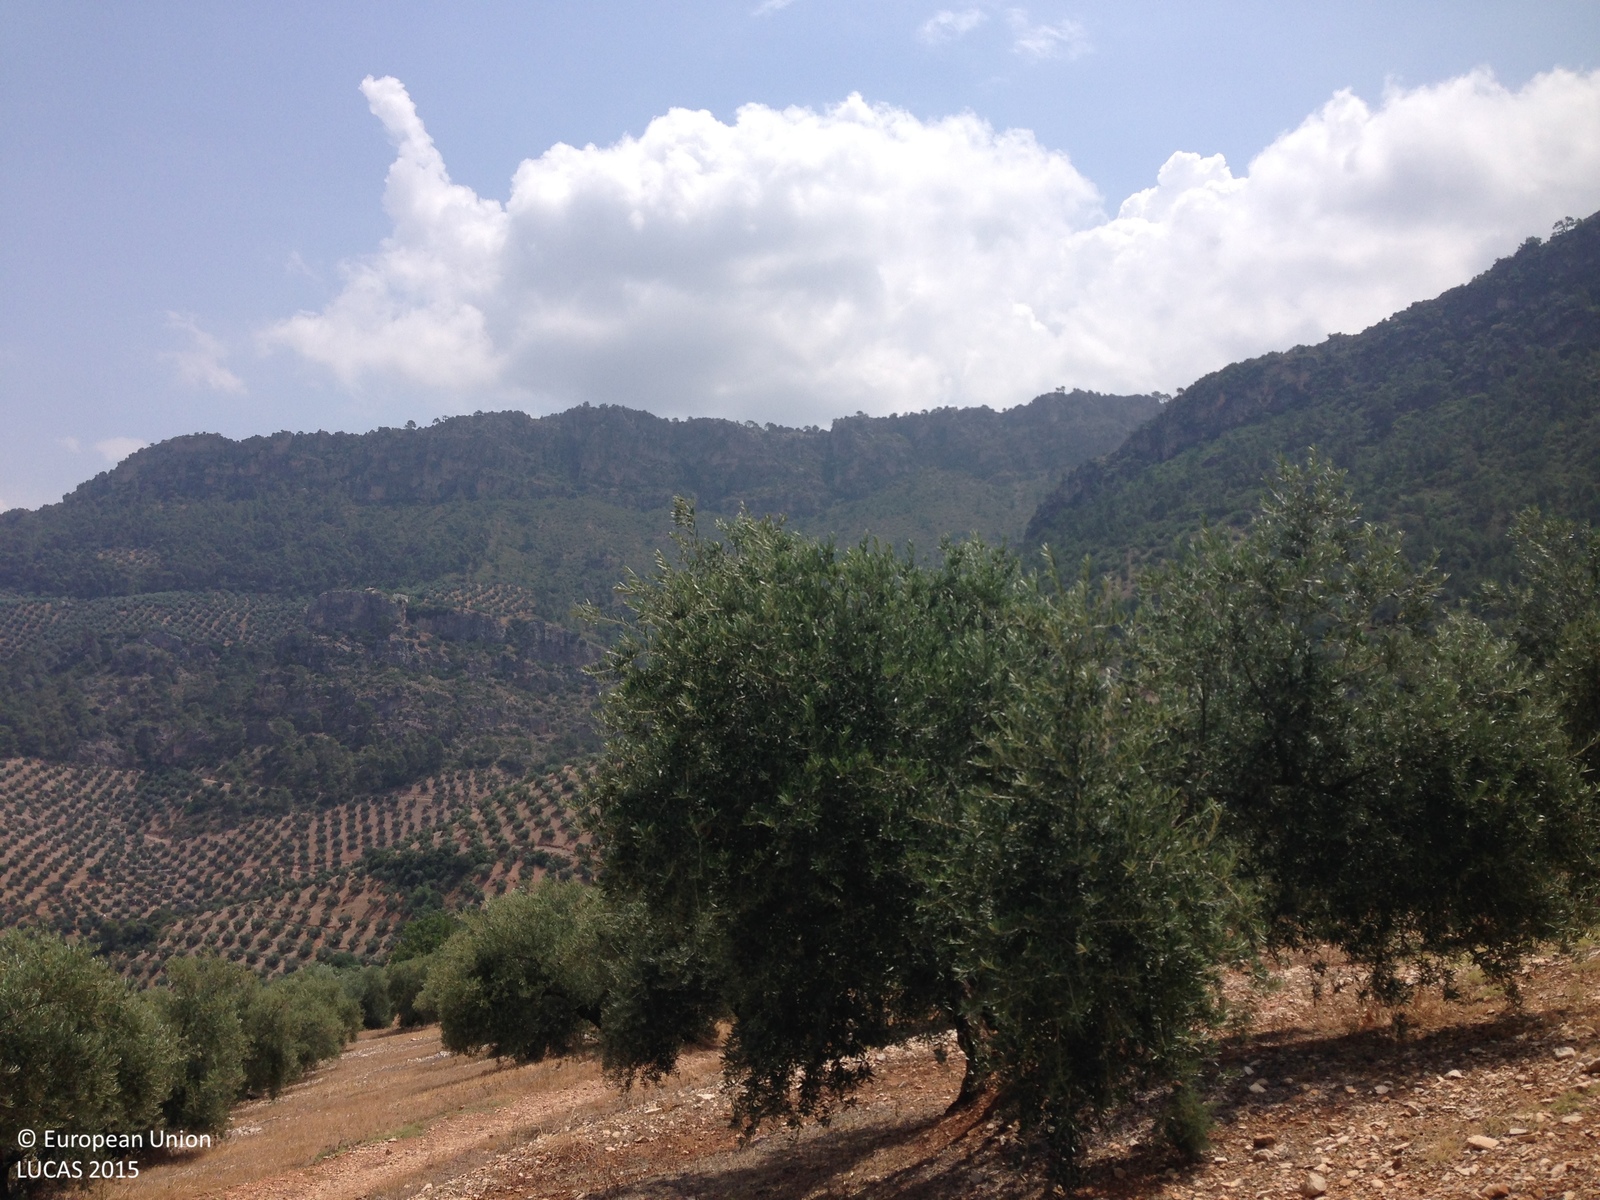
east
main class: Cropland
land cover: Olive groves
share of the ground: 25 - 50 %
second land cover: Other bare soil
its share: > 75 %
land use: Agriculture (excluding fallow land and kitchen gardens)
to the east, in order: Olive groves; Other bare soil; Tracks; Olive groves; Tracks; Olive groves; Electric lines; Olive groves
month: June
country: ES
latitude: 38.1657
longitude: -2.9068
